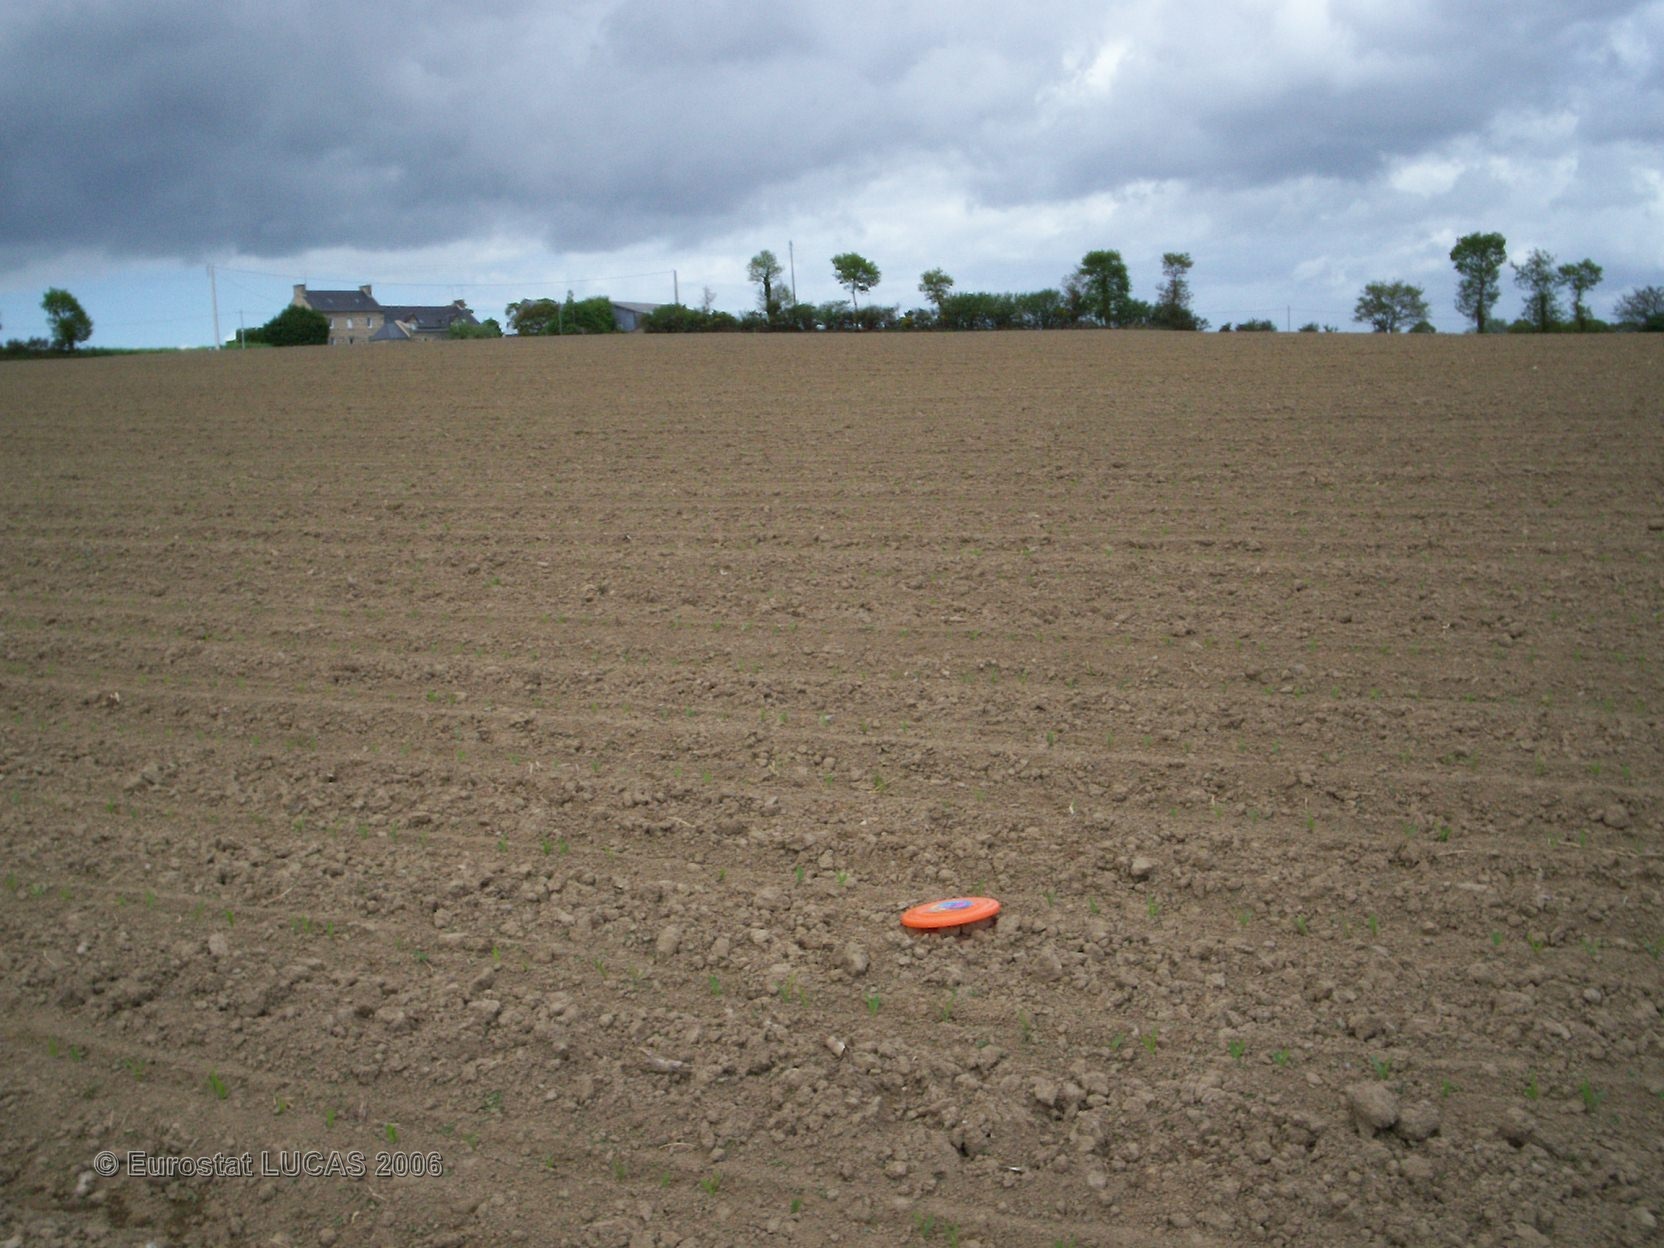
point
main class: Cropland
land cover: Maize
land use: Agriculture (excluding fallow land and kitchen gardens)
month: May
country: FR
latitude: 48.3783
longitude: -2.8528
